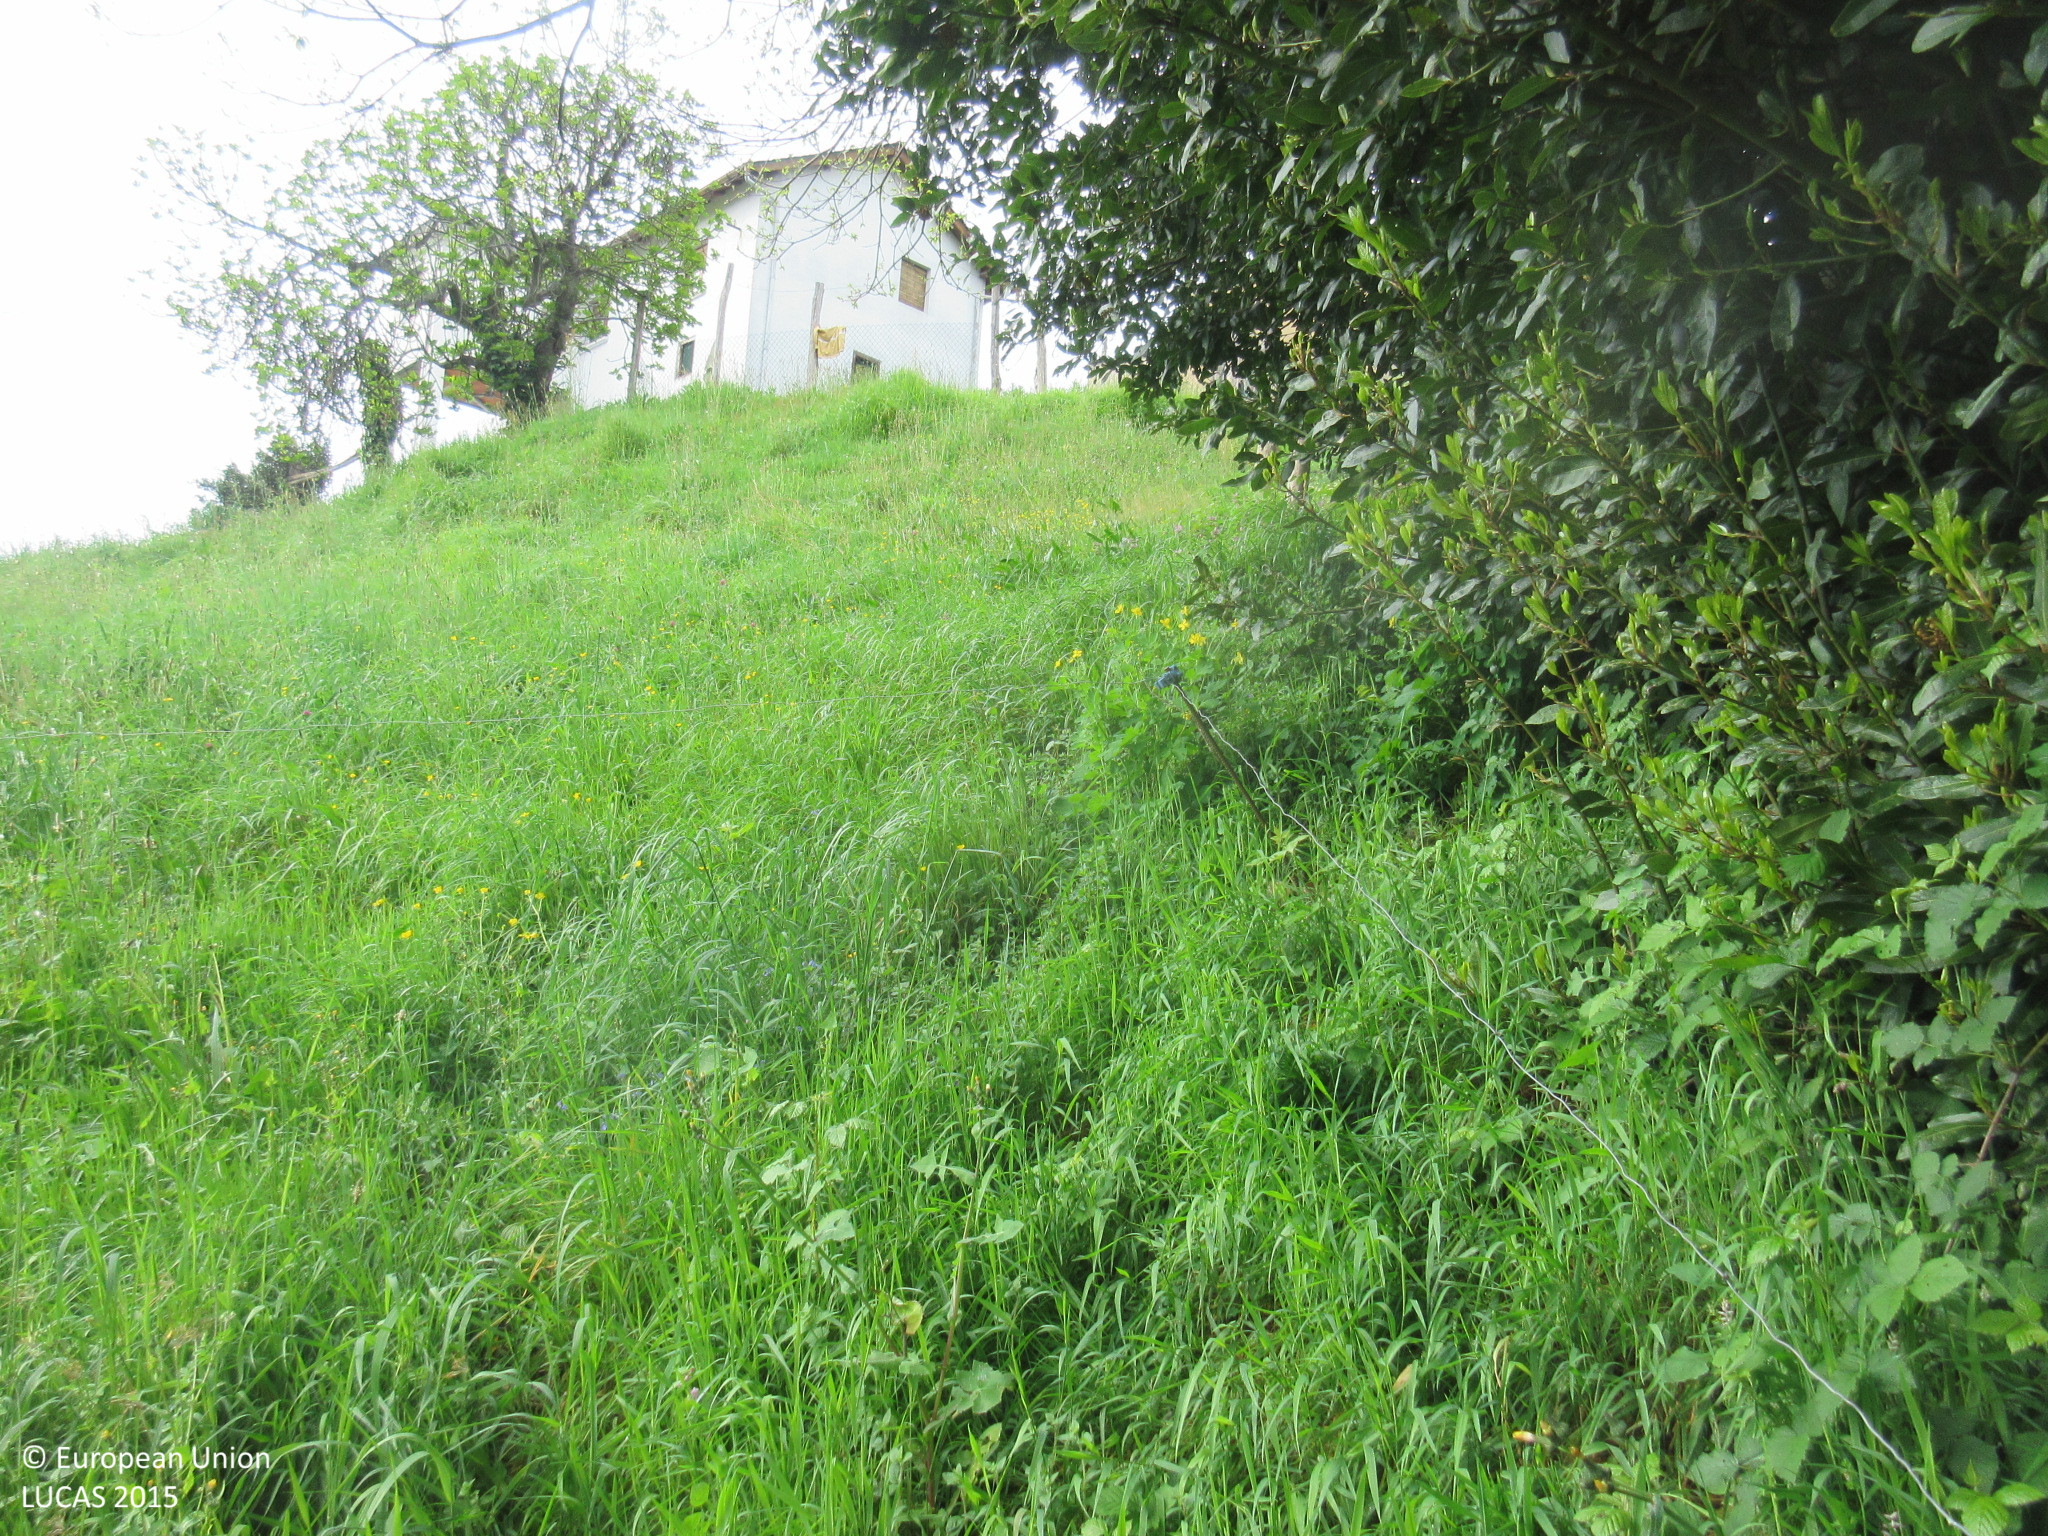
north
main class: Grassland
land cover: Grassland without tree/shrub cover
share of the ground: > 75 %
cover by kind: herbaceous plants 100 %
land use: Agriculture (excluding fallow land and kitchen gardens)
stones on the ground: 10 - 25 %
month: April
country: ES
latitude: 43.4923
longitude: -6.4130
